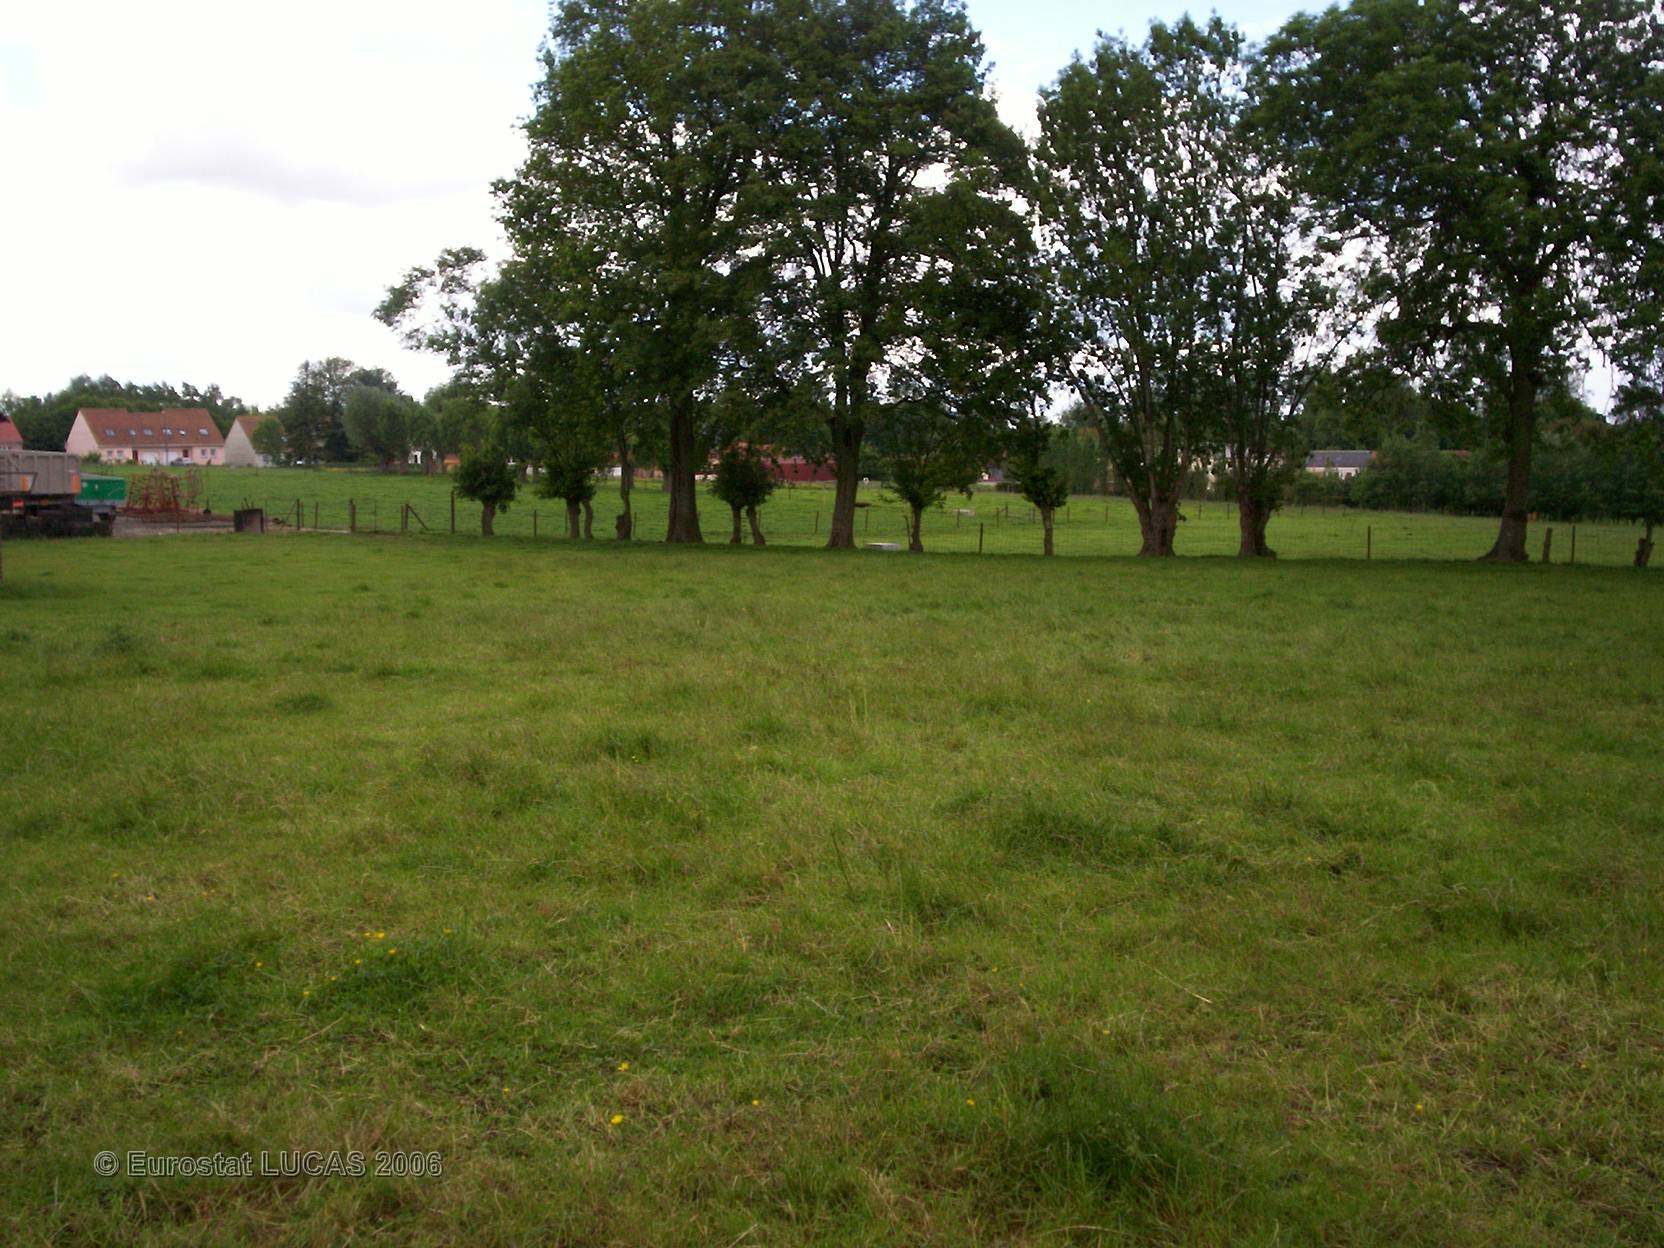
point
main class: Grassland
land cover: Grassland with sparse tree/shrub cover
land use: Agriculture (excluding fallow land and kitchen gardens)
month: May
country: FR
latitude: 50.1825
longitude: 2.6641
